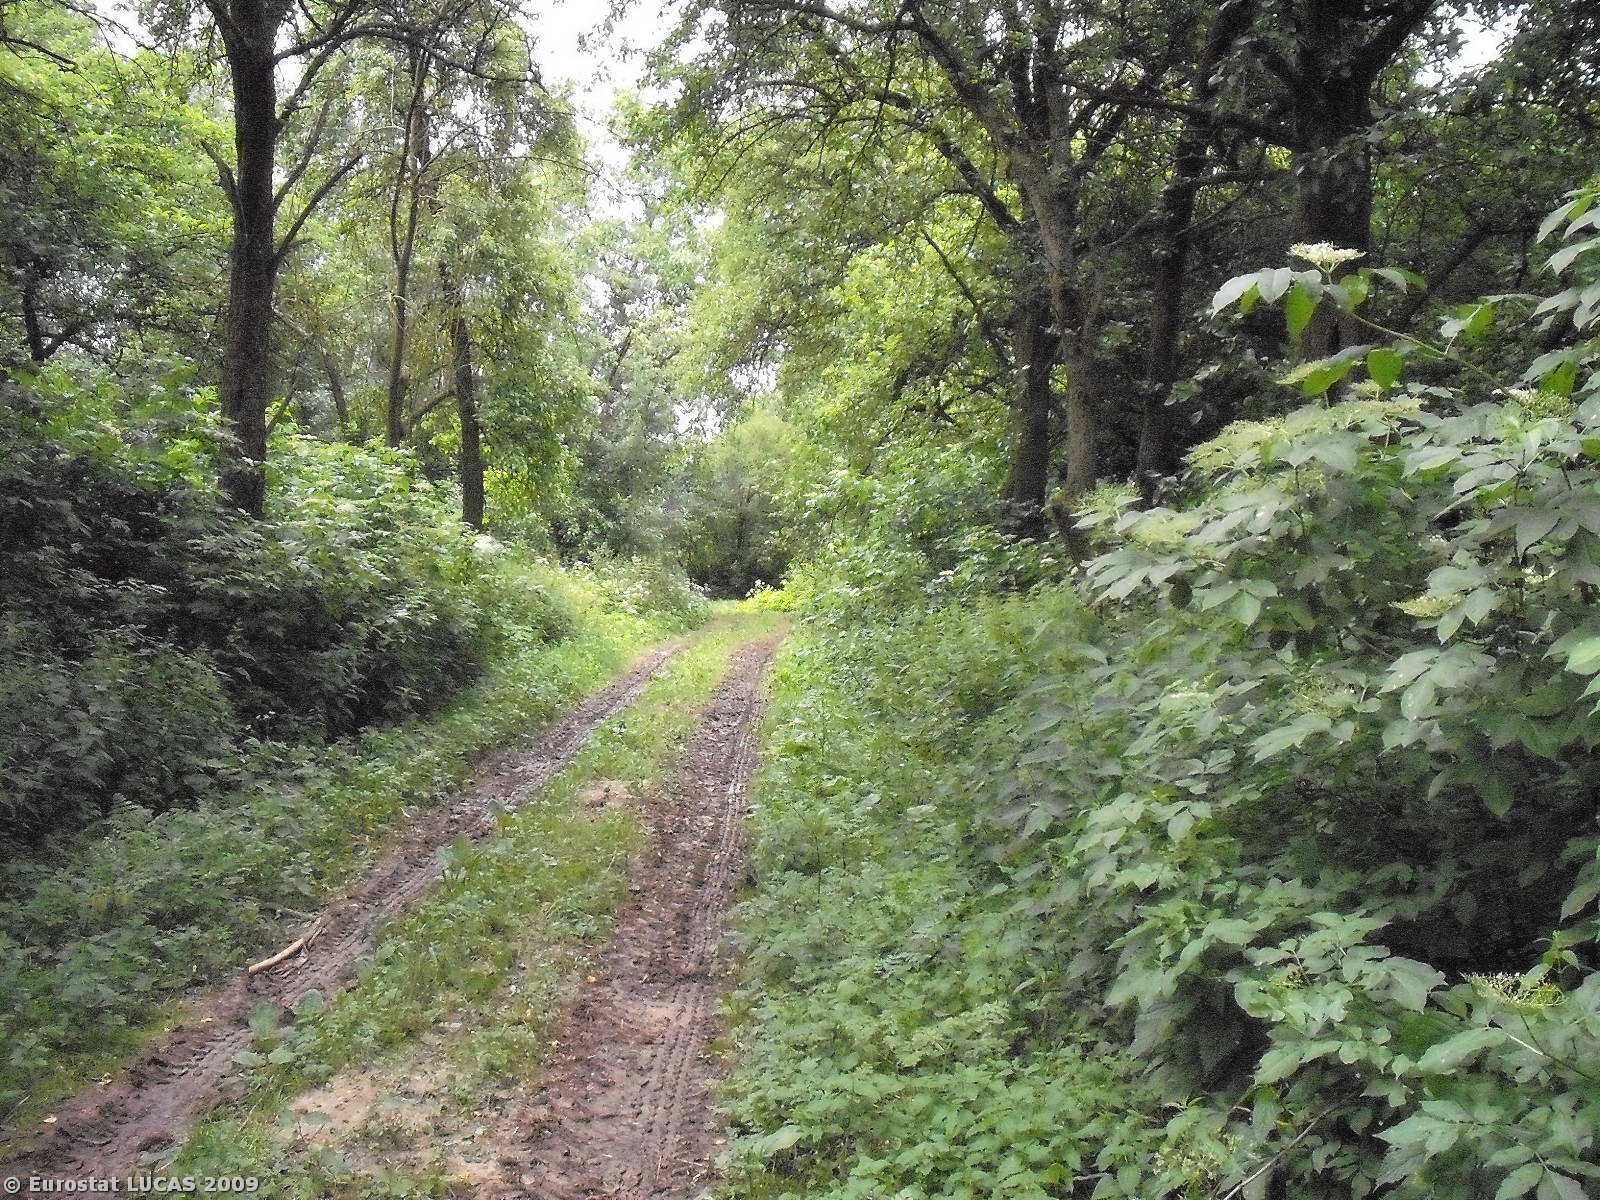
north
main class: Woodland
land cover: Broadleaved woodland
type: mesophytic deciduous forest
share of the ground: > 75 %
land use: Unused
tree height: > 5 m
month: June
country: PL
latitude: 50.7859
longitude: 21.2676
